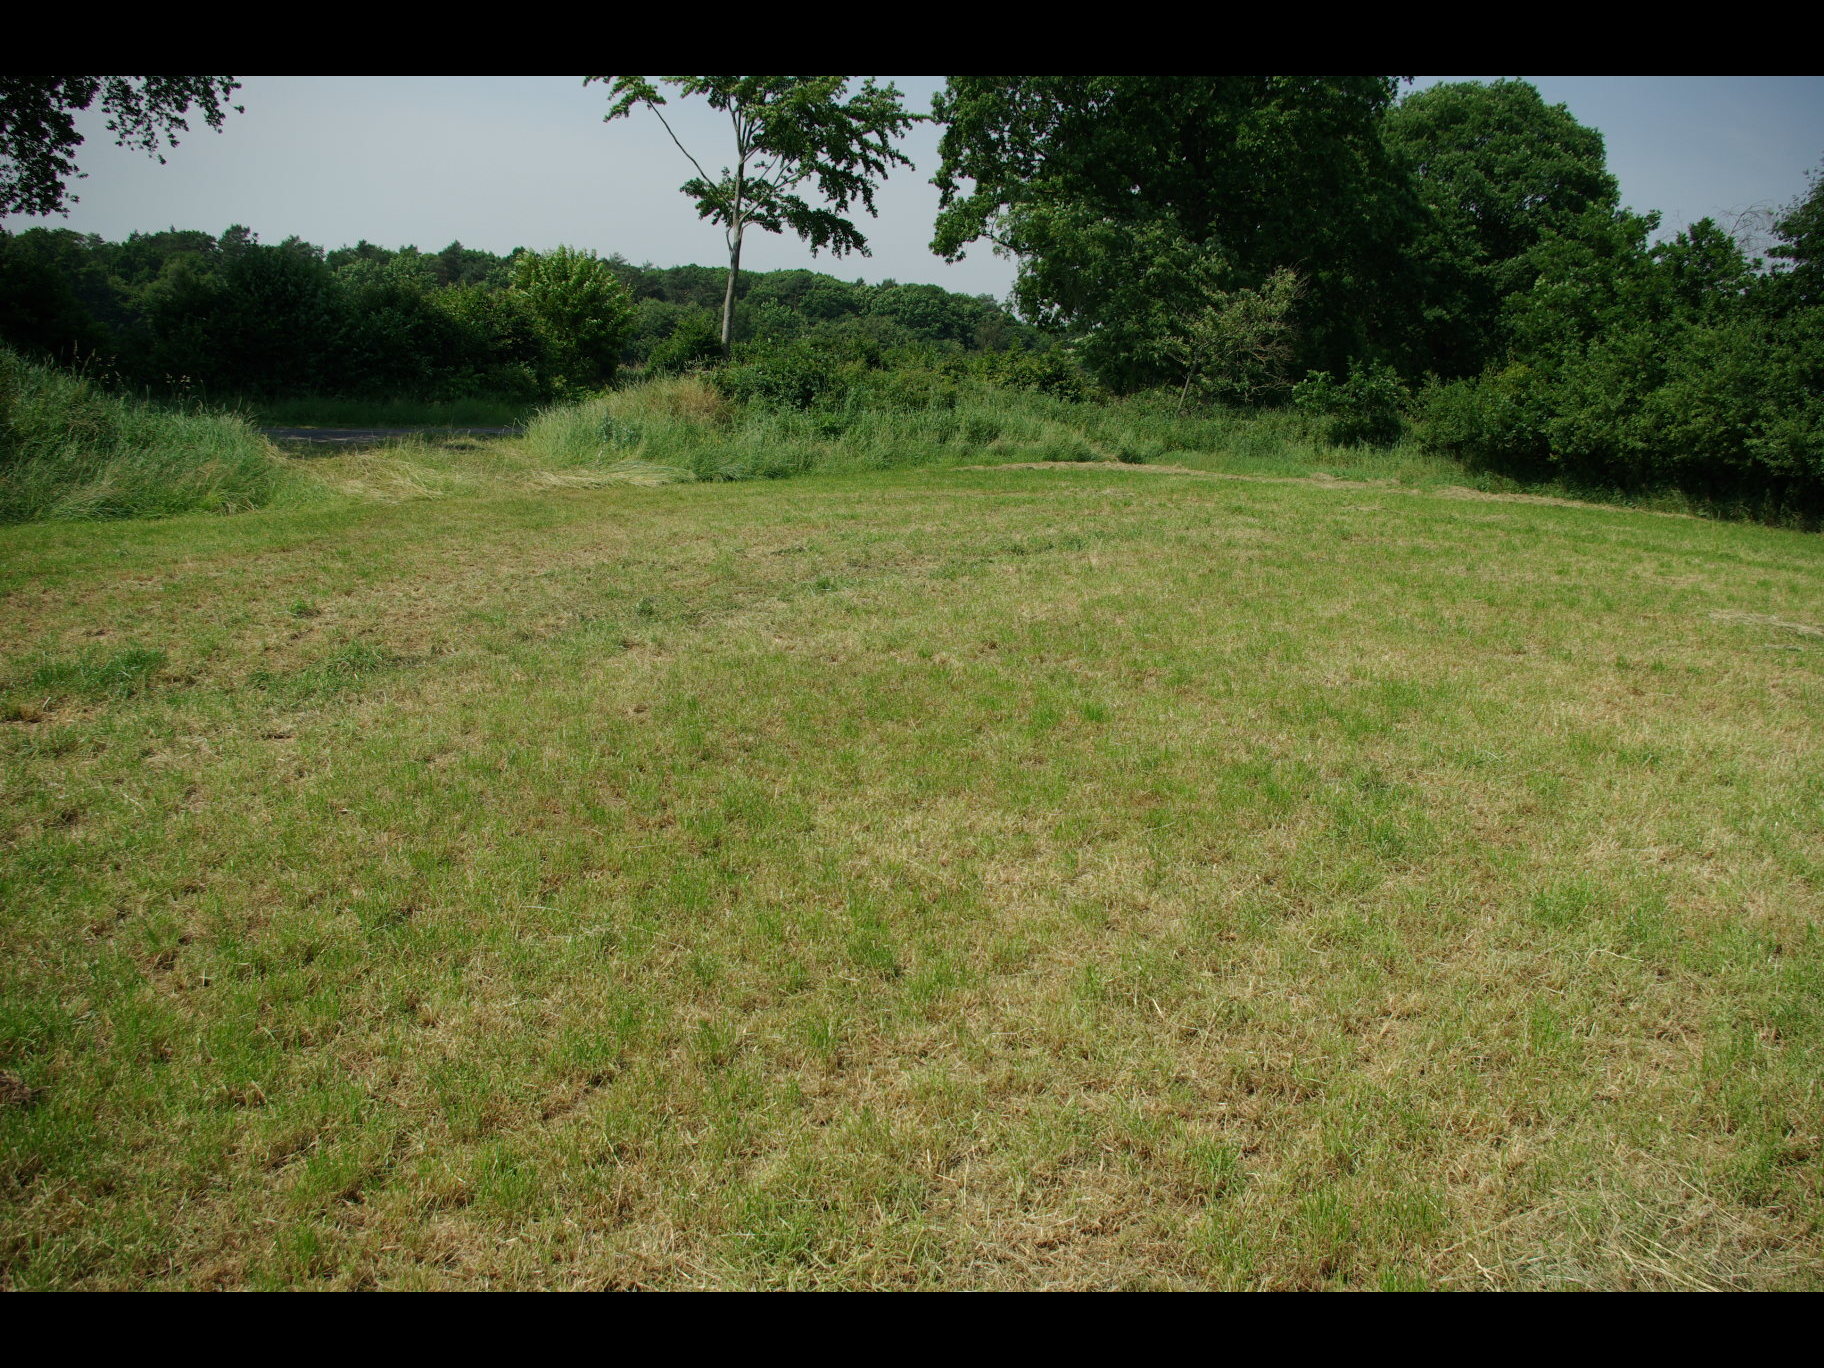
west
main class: Grassland
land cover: Grassland without tree/shrub cover
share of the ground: > 75 %
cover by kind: herbaceous plants 100 %
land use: Agriculture (excluding fallow land and kitchen gardens)
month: July
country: DE
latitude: 54.2641
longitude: 9.6471
